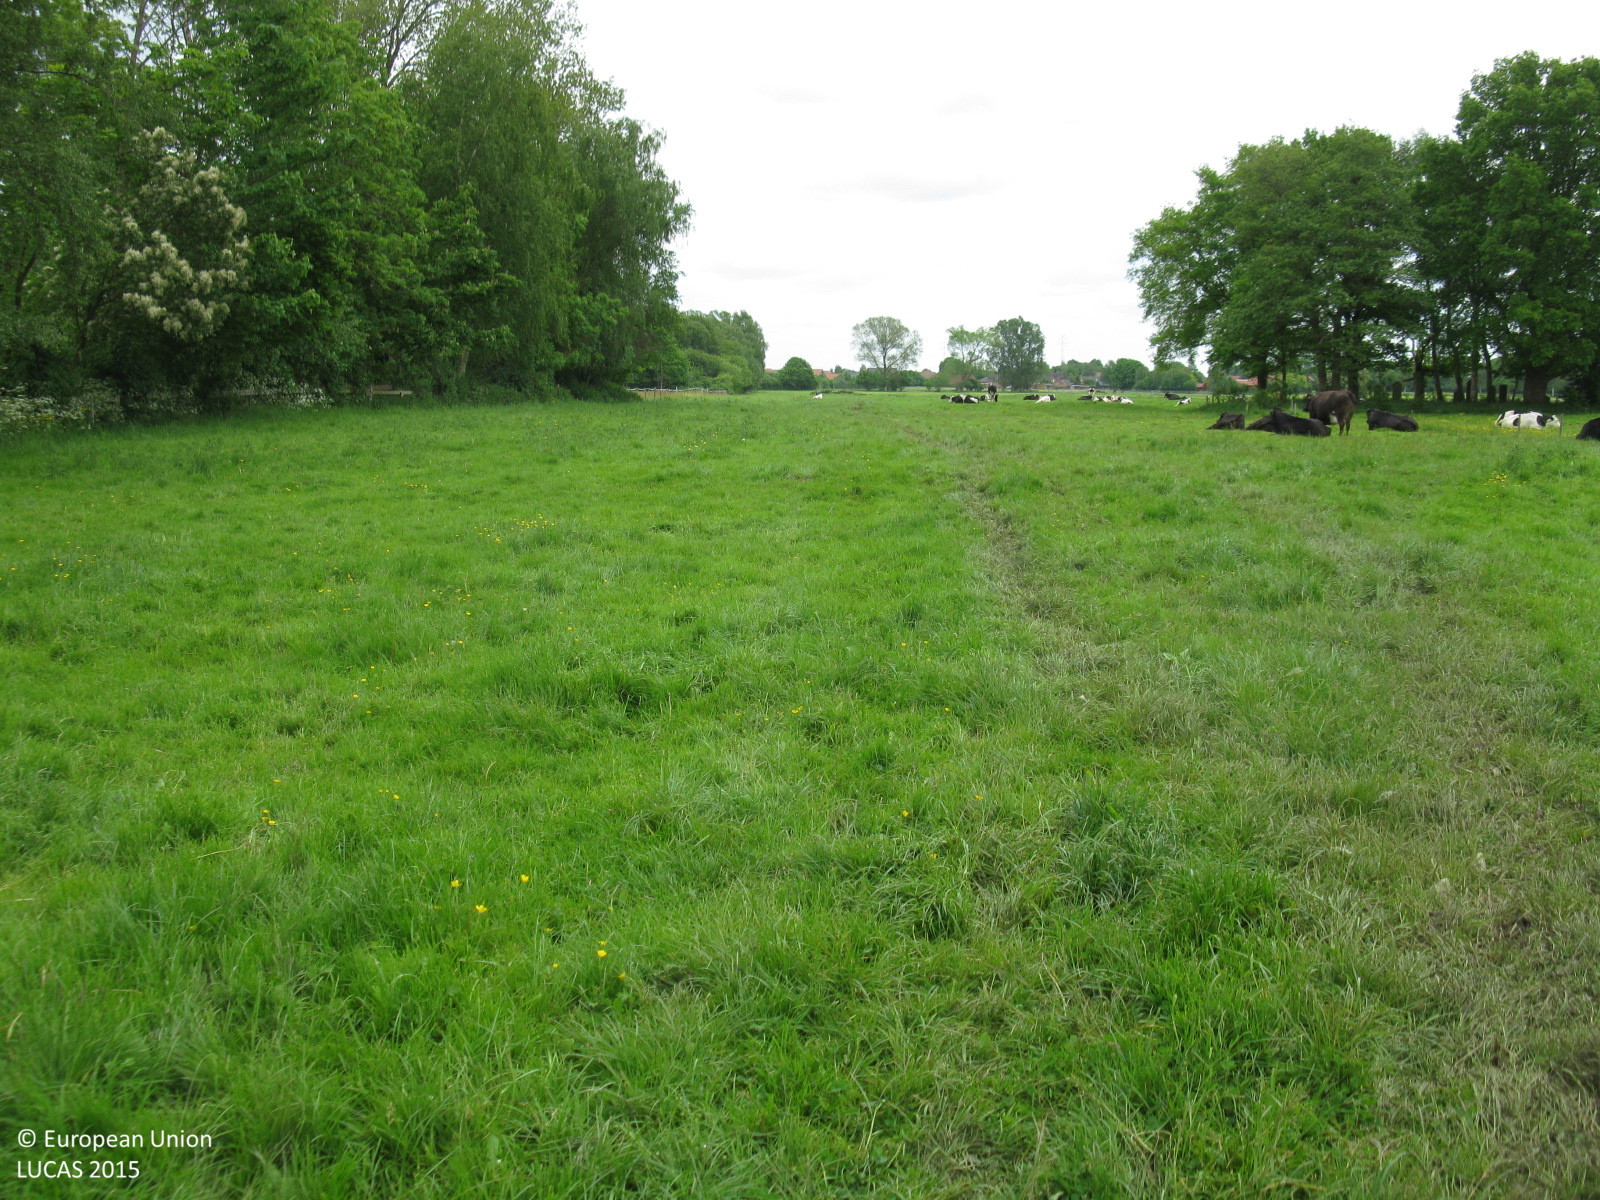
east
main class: Grassland
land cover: Grassland without tree/shrub cover
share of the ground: > 75 %
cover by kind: herbaceous plants 100 %
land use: Agriculture (excluding fallow land and kitchen gardens)
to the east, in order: Grassland without tree/shrub cover; Fences; Grassland without tree/shrub cover; Fences; Broadleaved woodland
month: June
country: DE
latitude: 53.1566
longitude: 7.3236
